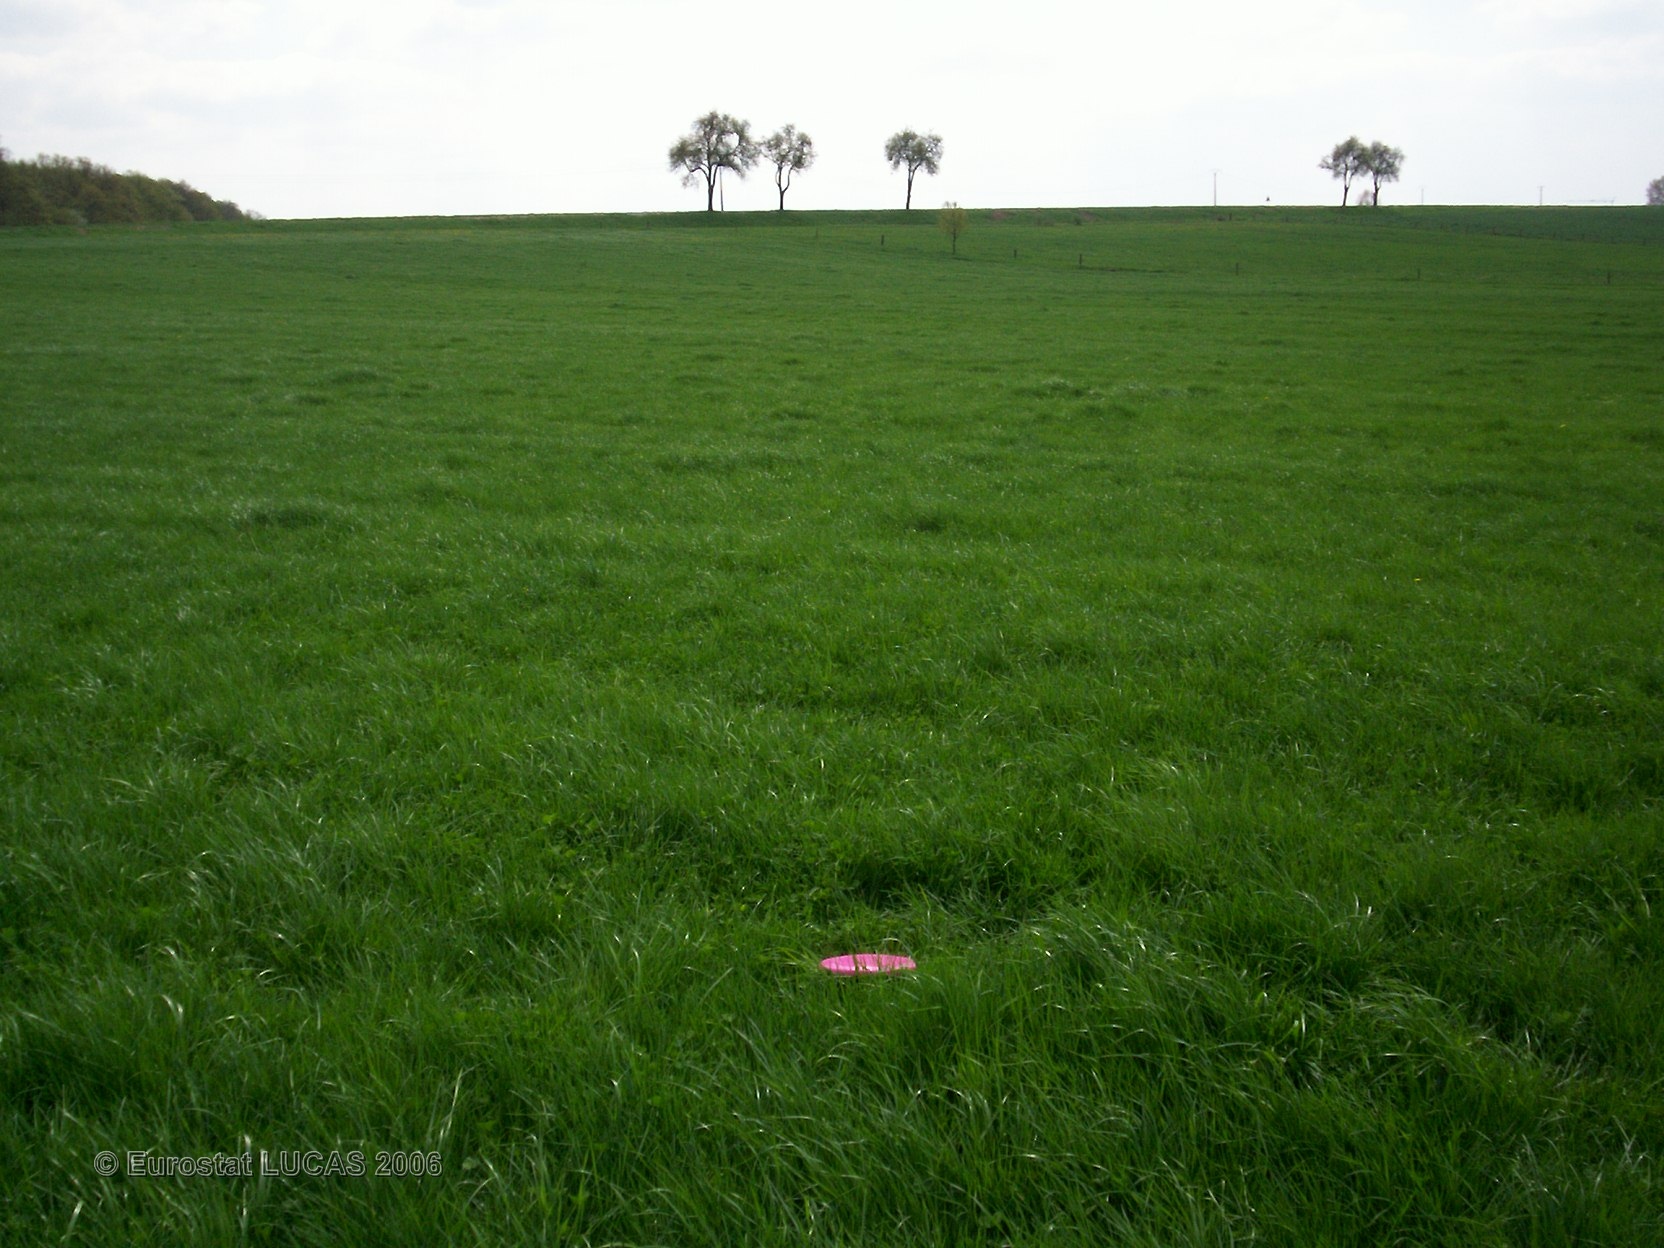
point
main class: Grassland
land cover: Grassland without tree/shrub cover
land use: Agriculture (excluding fallow land and kitchen gardens)
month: April
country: FR
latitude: 48.9863
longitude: 6.7617
